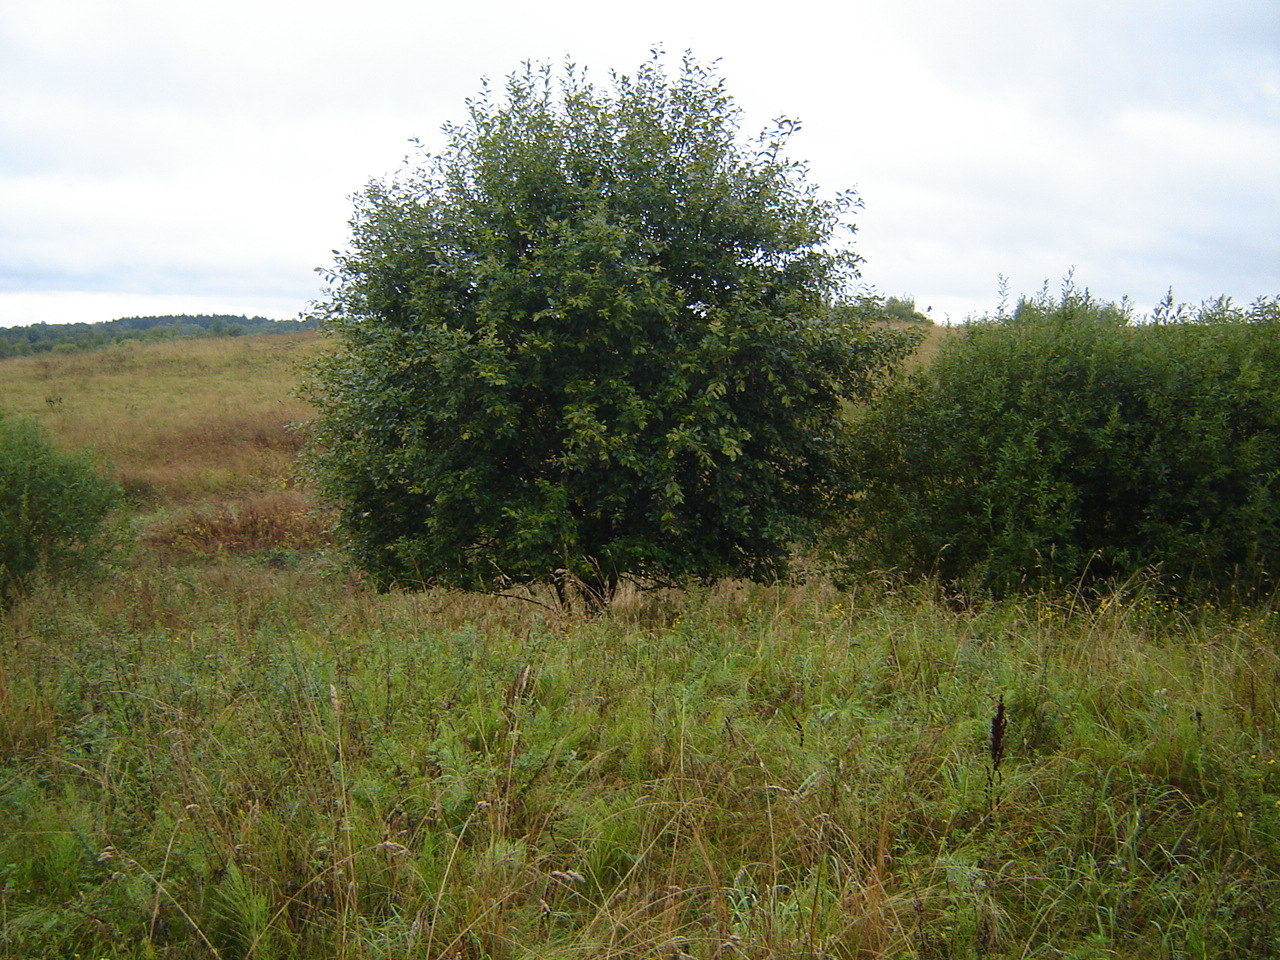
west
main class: Grassland
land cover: Spontaneously vegetated surfaces
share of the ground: > 75 %
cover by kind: herbaceous plants 100 %
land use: Fallow land
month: September
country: LT
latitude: 55.0189
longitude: 25.3399
